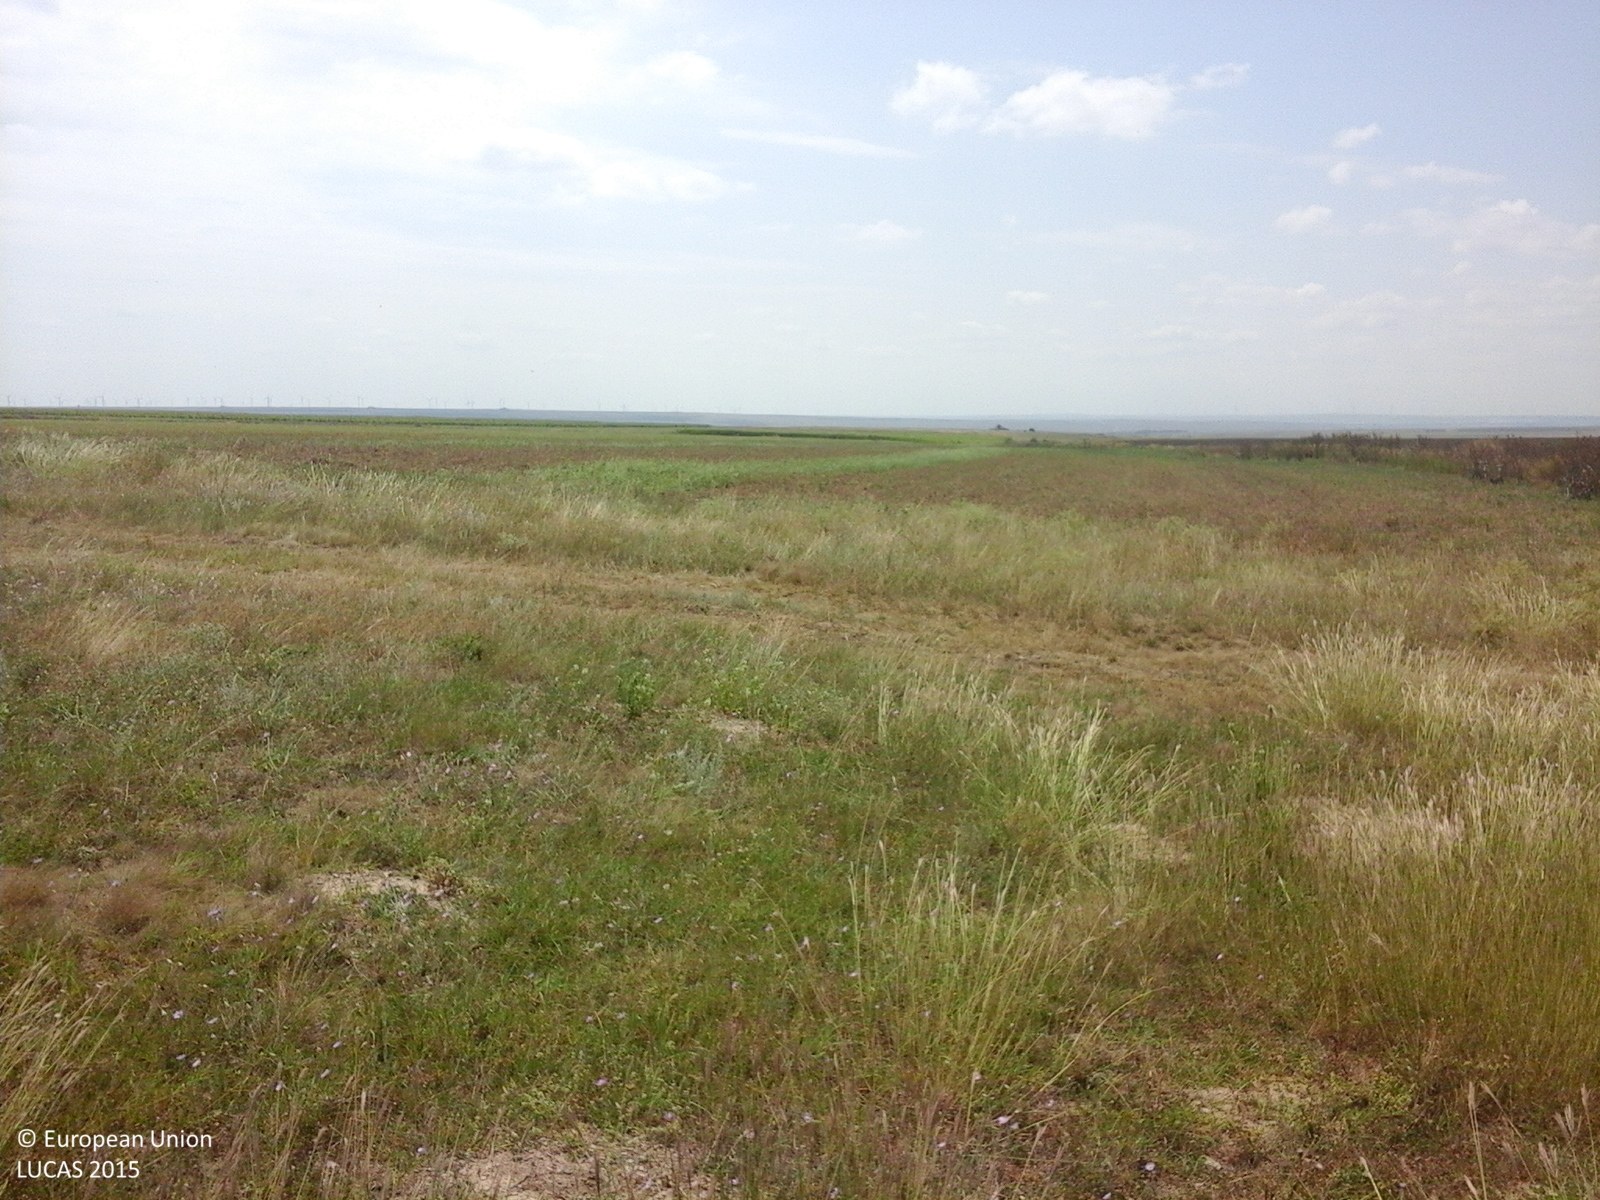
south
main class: Grassland
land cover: Spontaneously vegetated surfaces
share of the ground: > 75 %
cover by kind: herbaceous plants 100 %
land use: Fallow land
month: August
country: RO
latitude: 44.6852
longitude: 28.4826
